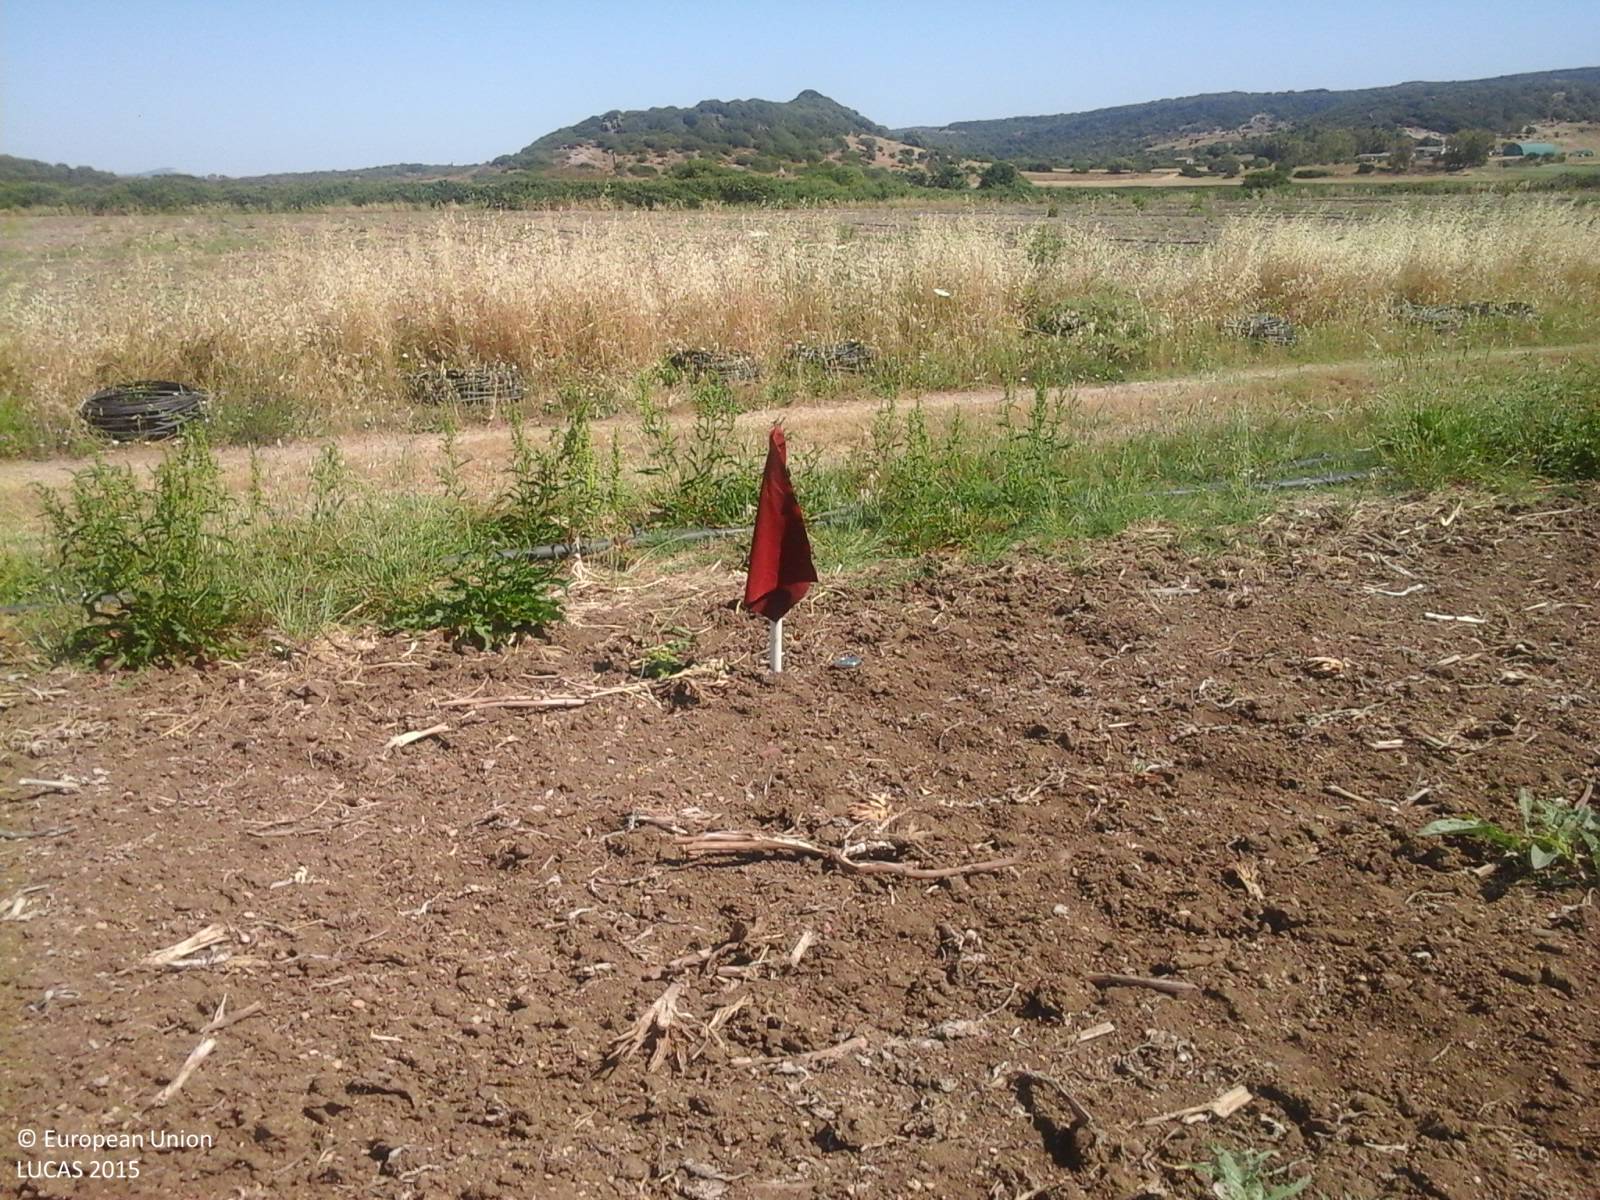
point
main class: Cropland
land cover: Other fresh vegetables
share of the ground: < 10 %
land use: Agriculture (excluding fallow land and kitchen gardens)
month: June
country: IT
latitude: 40.6161
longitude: 8.3885
